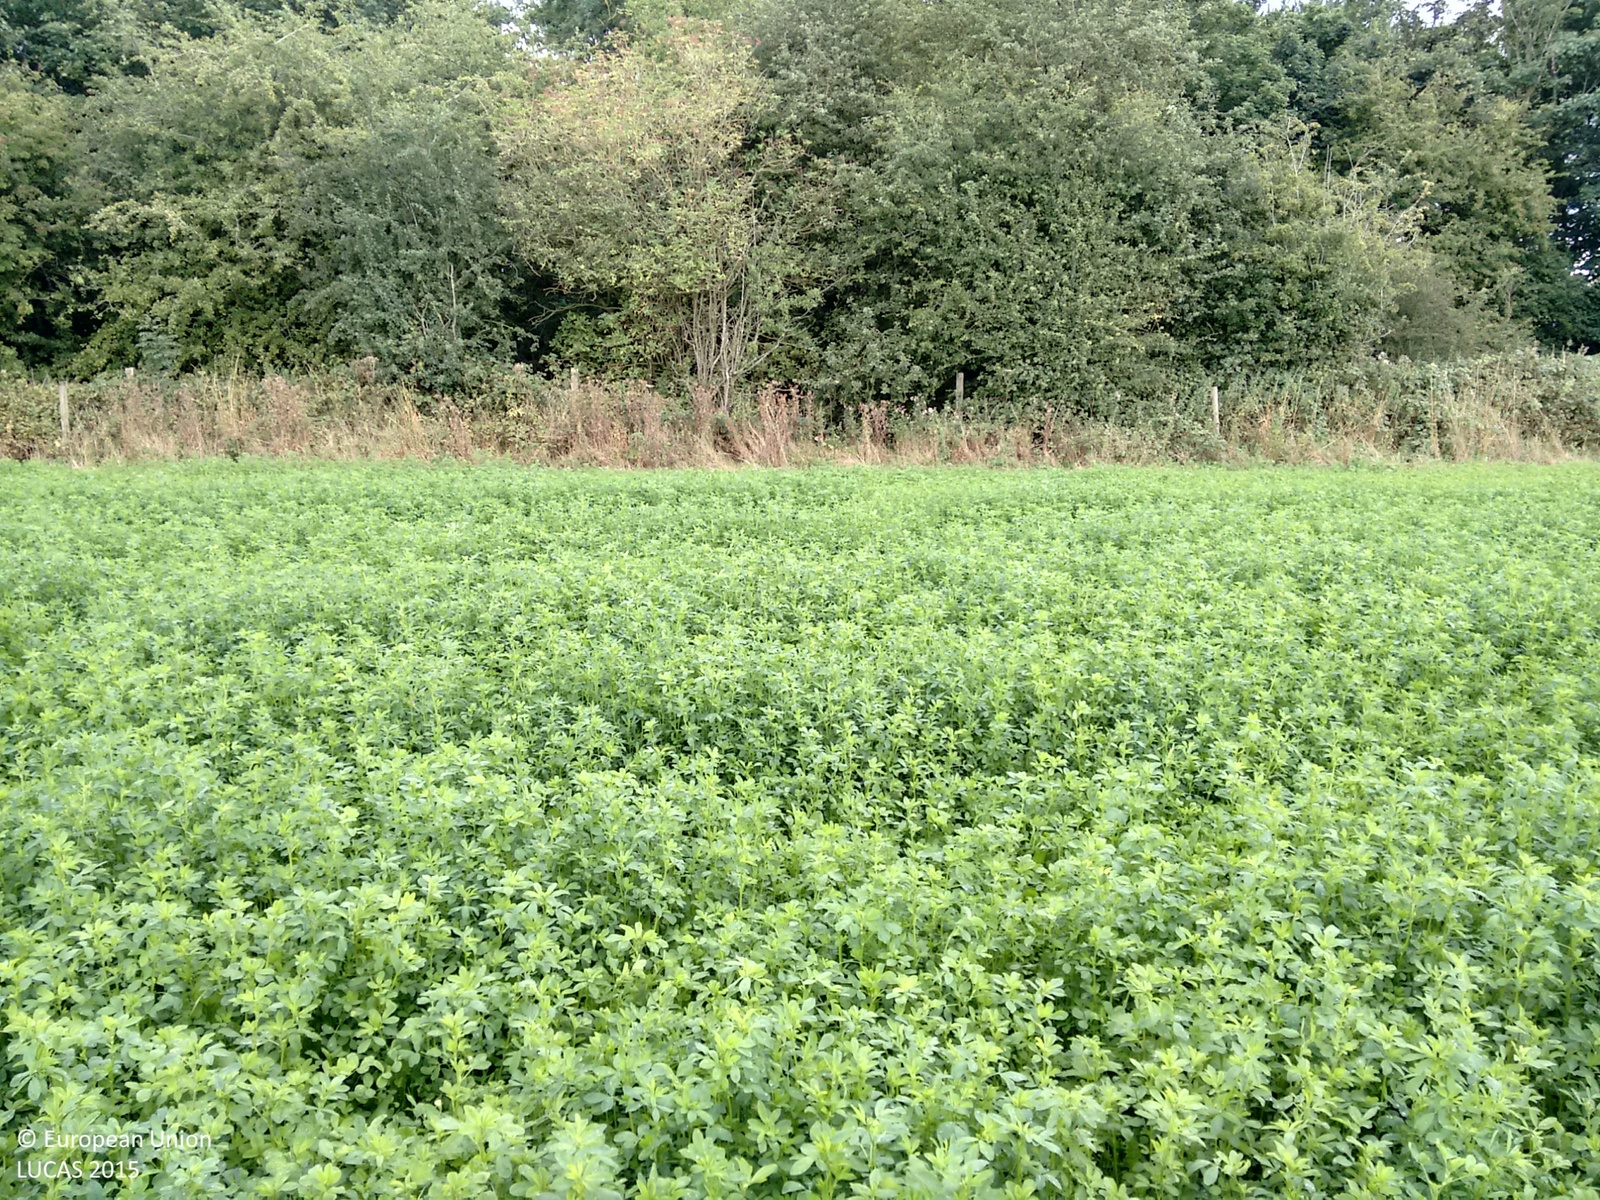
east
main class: Cropland
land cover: Lucerne
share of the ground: > 75 %
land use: Agriculture (excluding fallow land and kitchen gardens)
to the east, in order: Lucerne; Grass margins; Fences; Broadleaved woodland; Paved roads, cycling and walking lanes; Broadleaved woodland; Fences; Grassland without tree/shrub cover
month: September
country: GB
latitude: 52.4817
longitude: -1.1933
